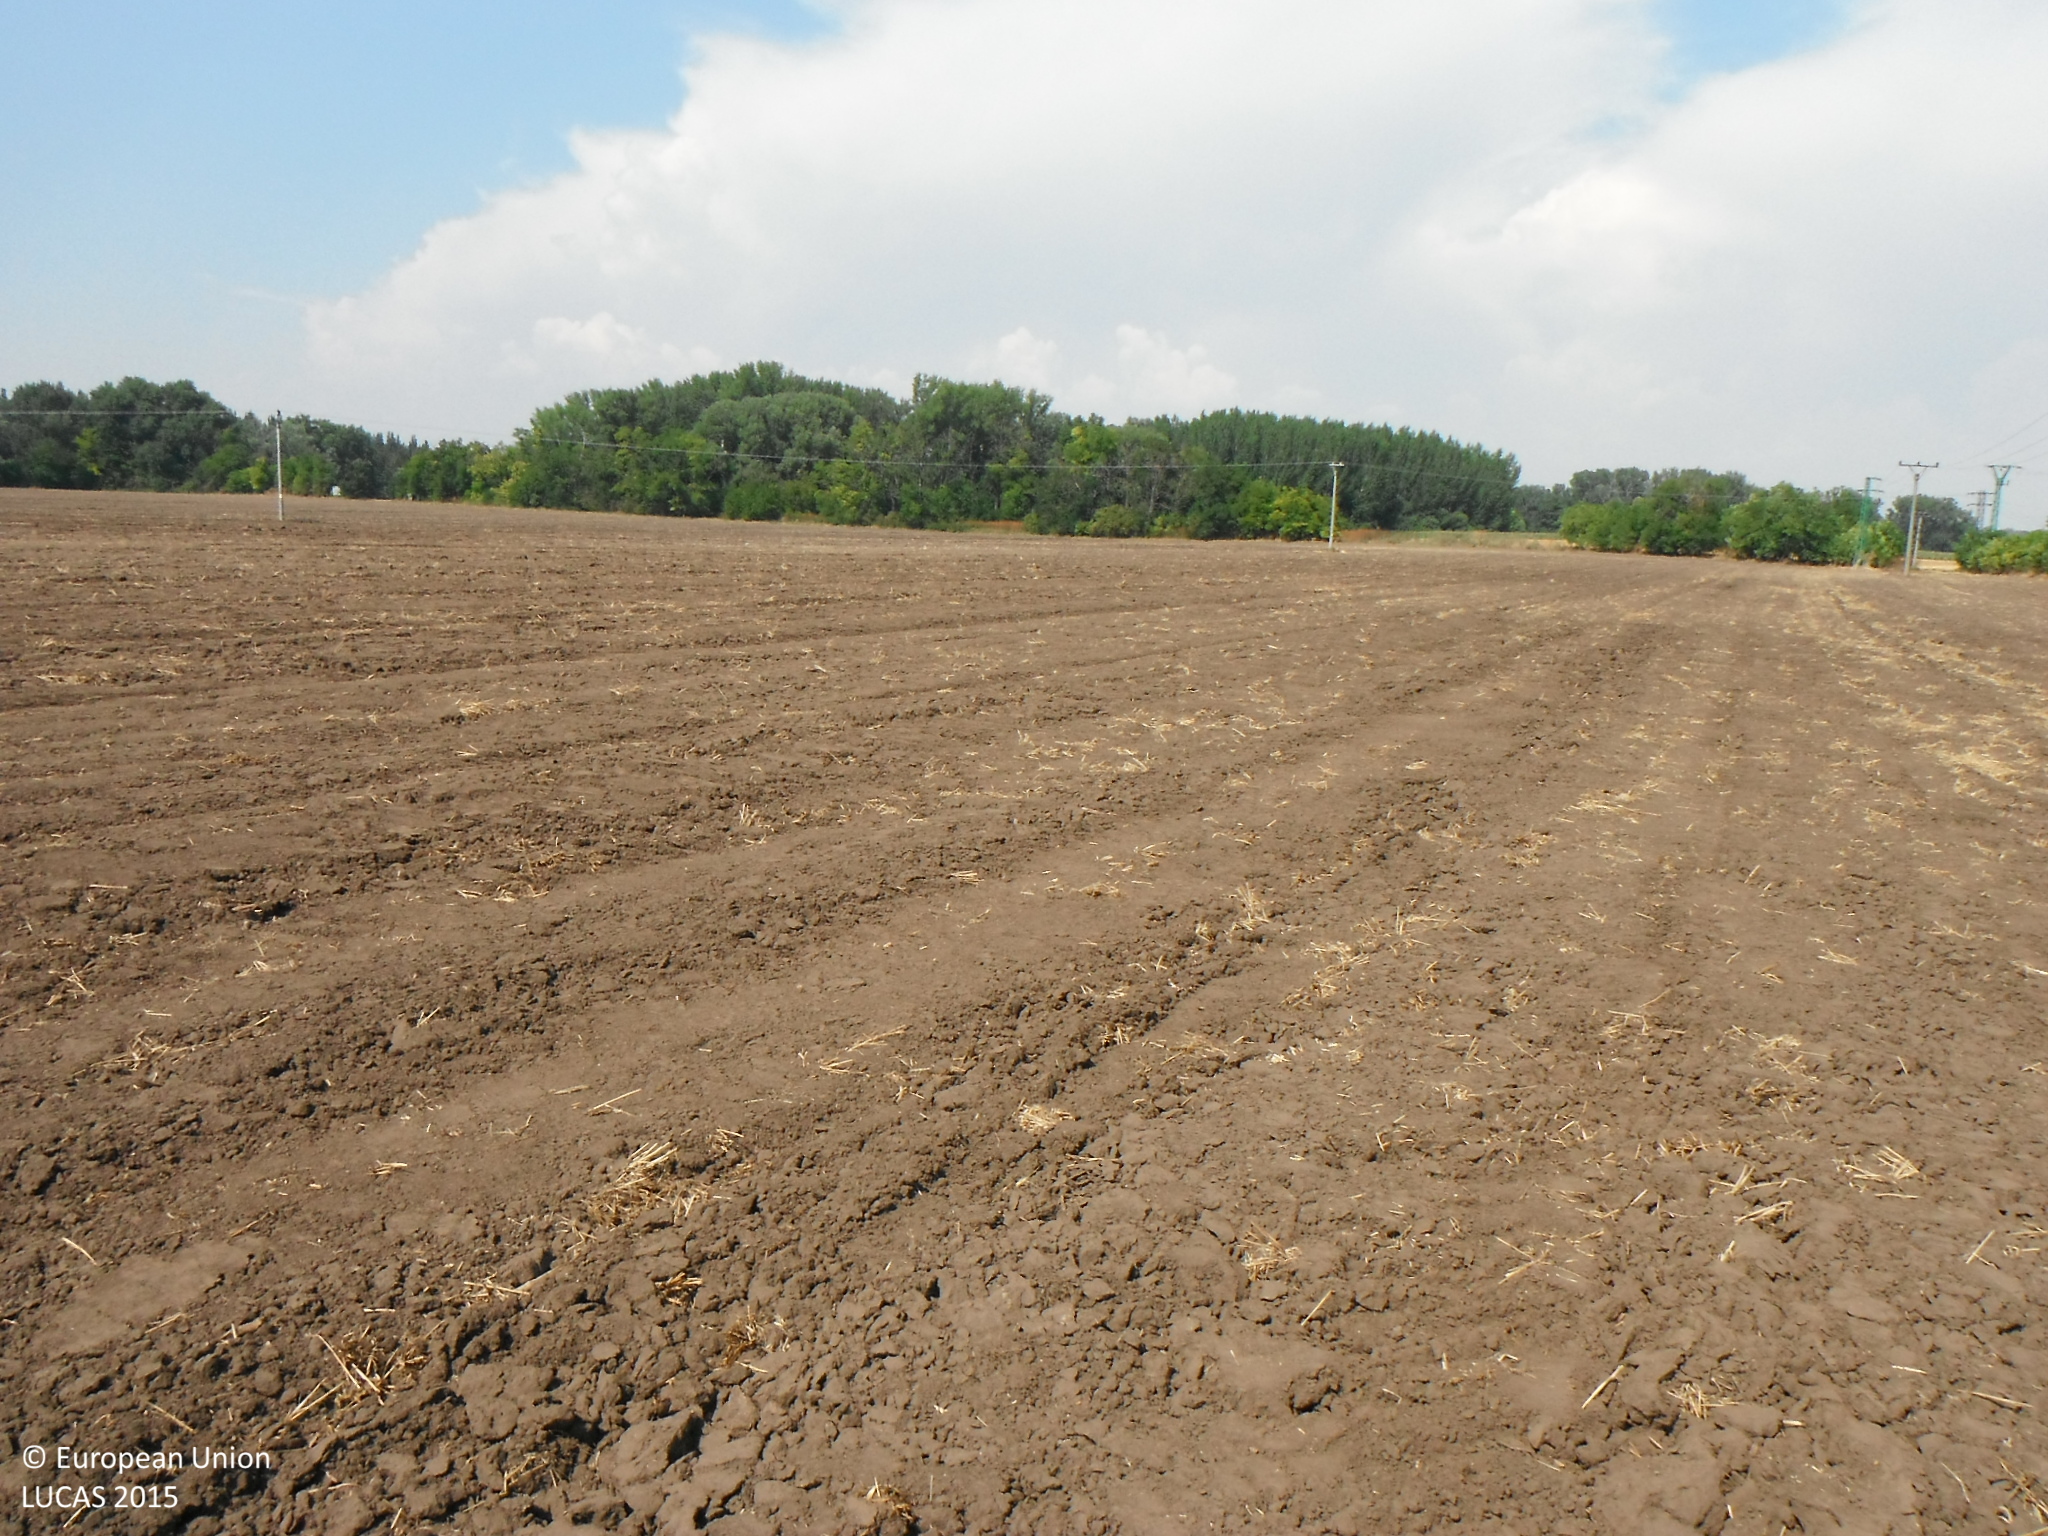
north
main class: Cropland
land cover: Common wheat
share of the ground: < 10 %
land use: Agriculture (excluding fallow land and kitchen gardens)
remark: Harvested field
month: August
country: SK
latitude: 48.0079
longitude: 18.2038
